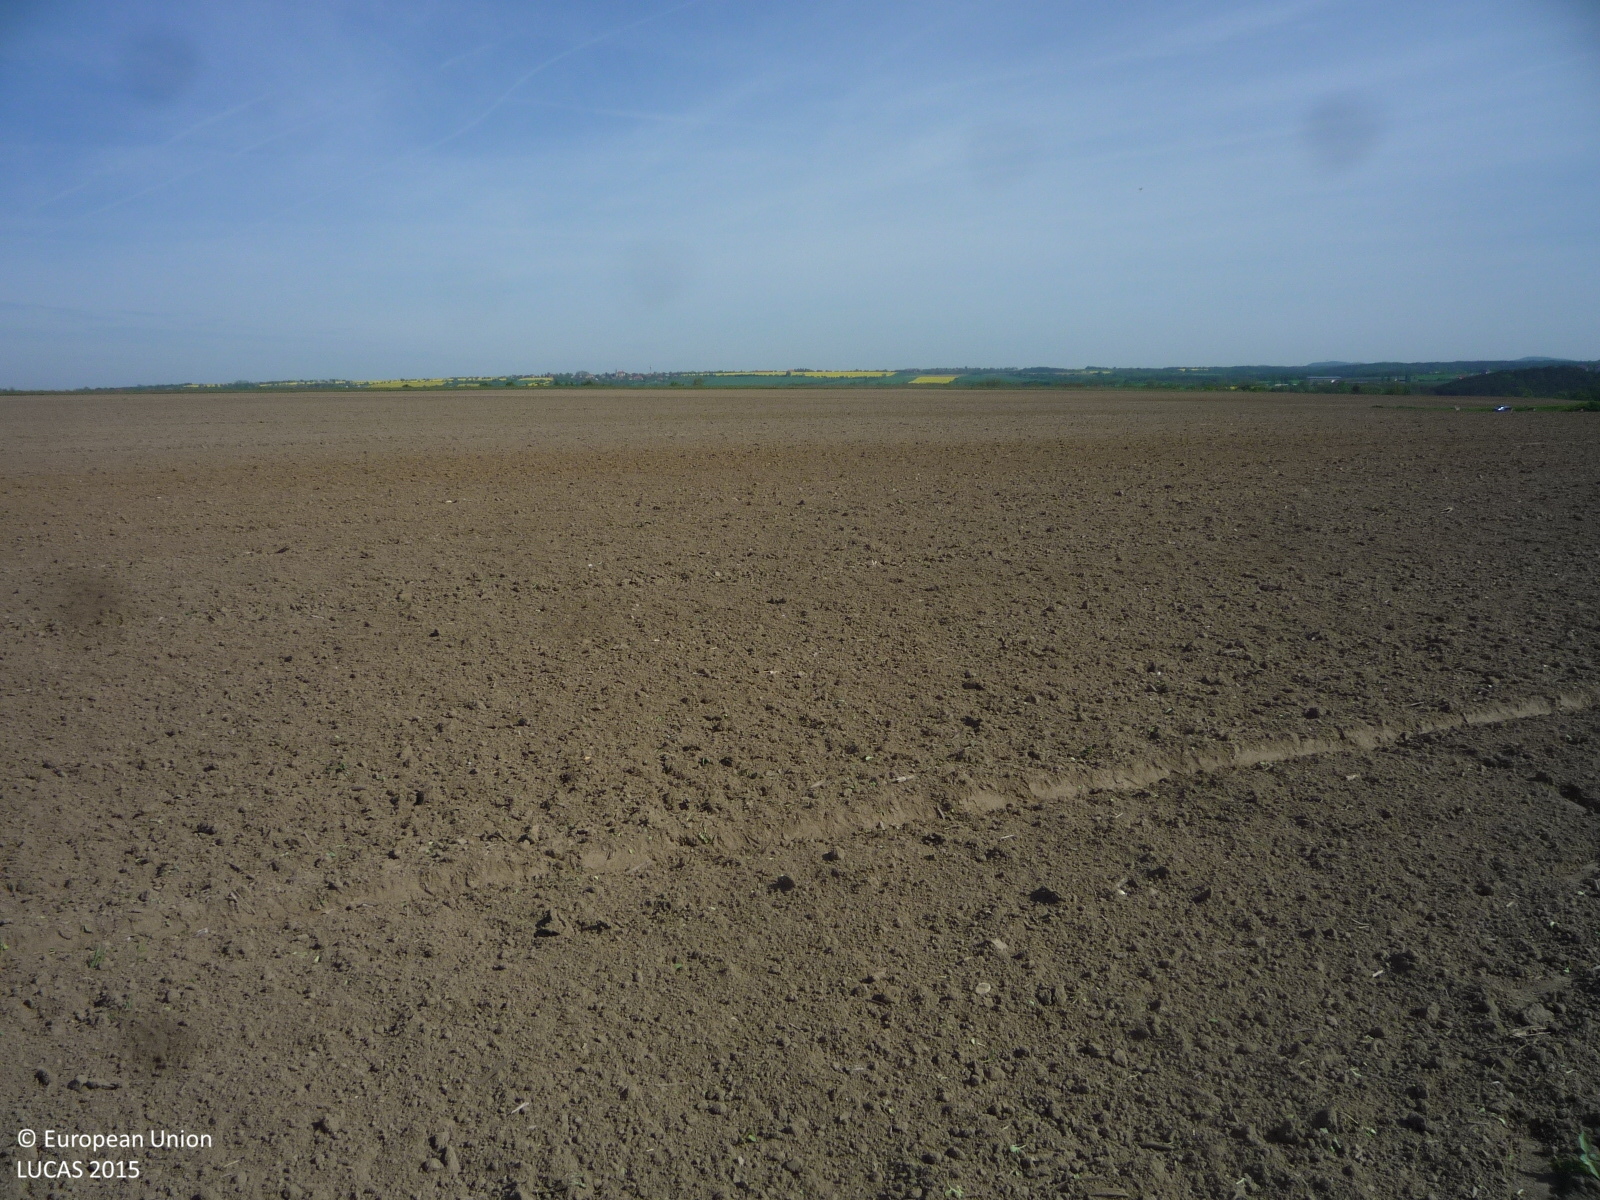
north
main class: Cropland
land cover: Dry pulses
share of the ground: < 10 %
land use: Agriculture (excluding fallow land and kitchen gardens)
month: May
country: CZ
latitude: 50.3639
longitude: 14.5425
